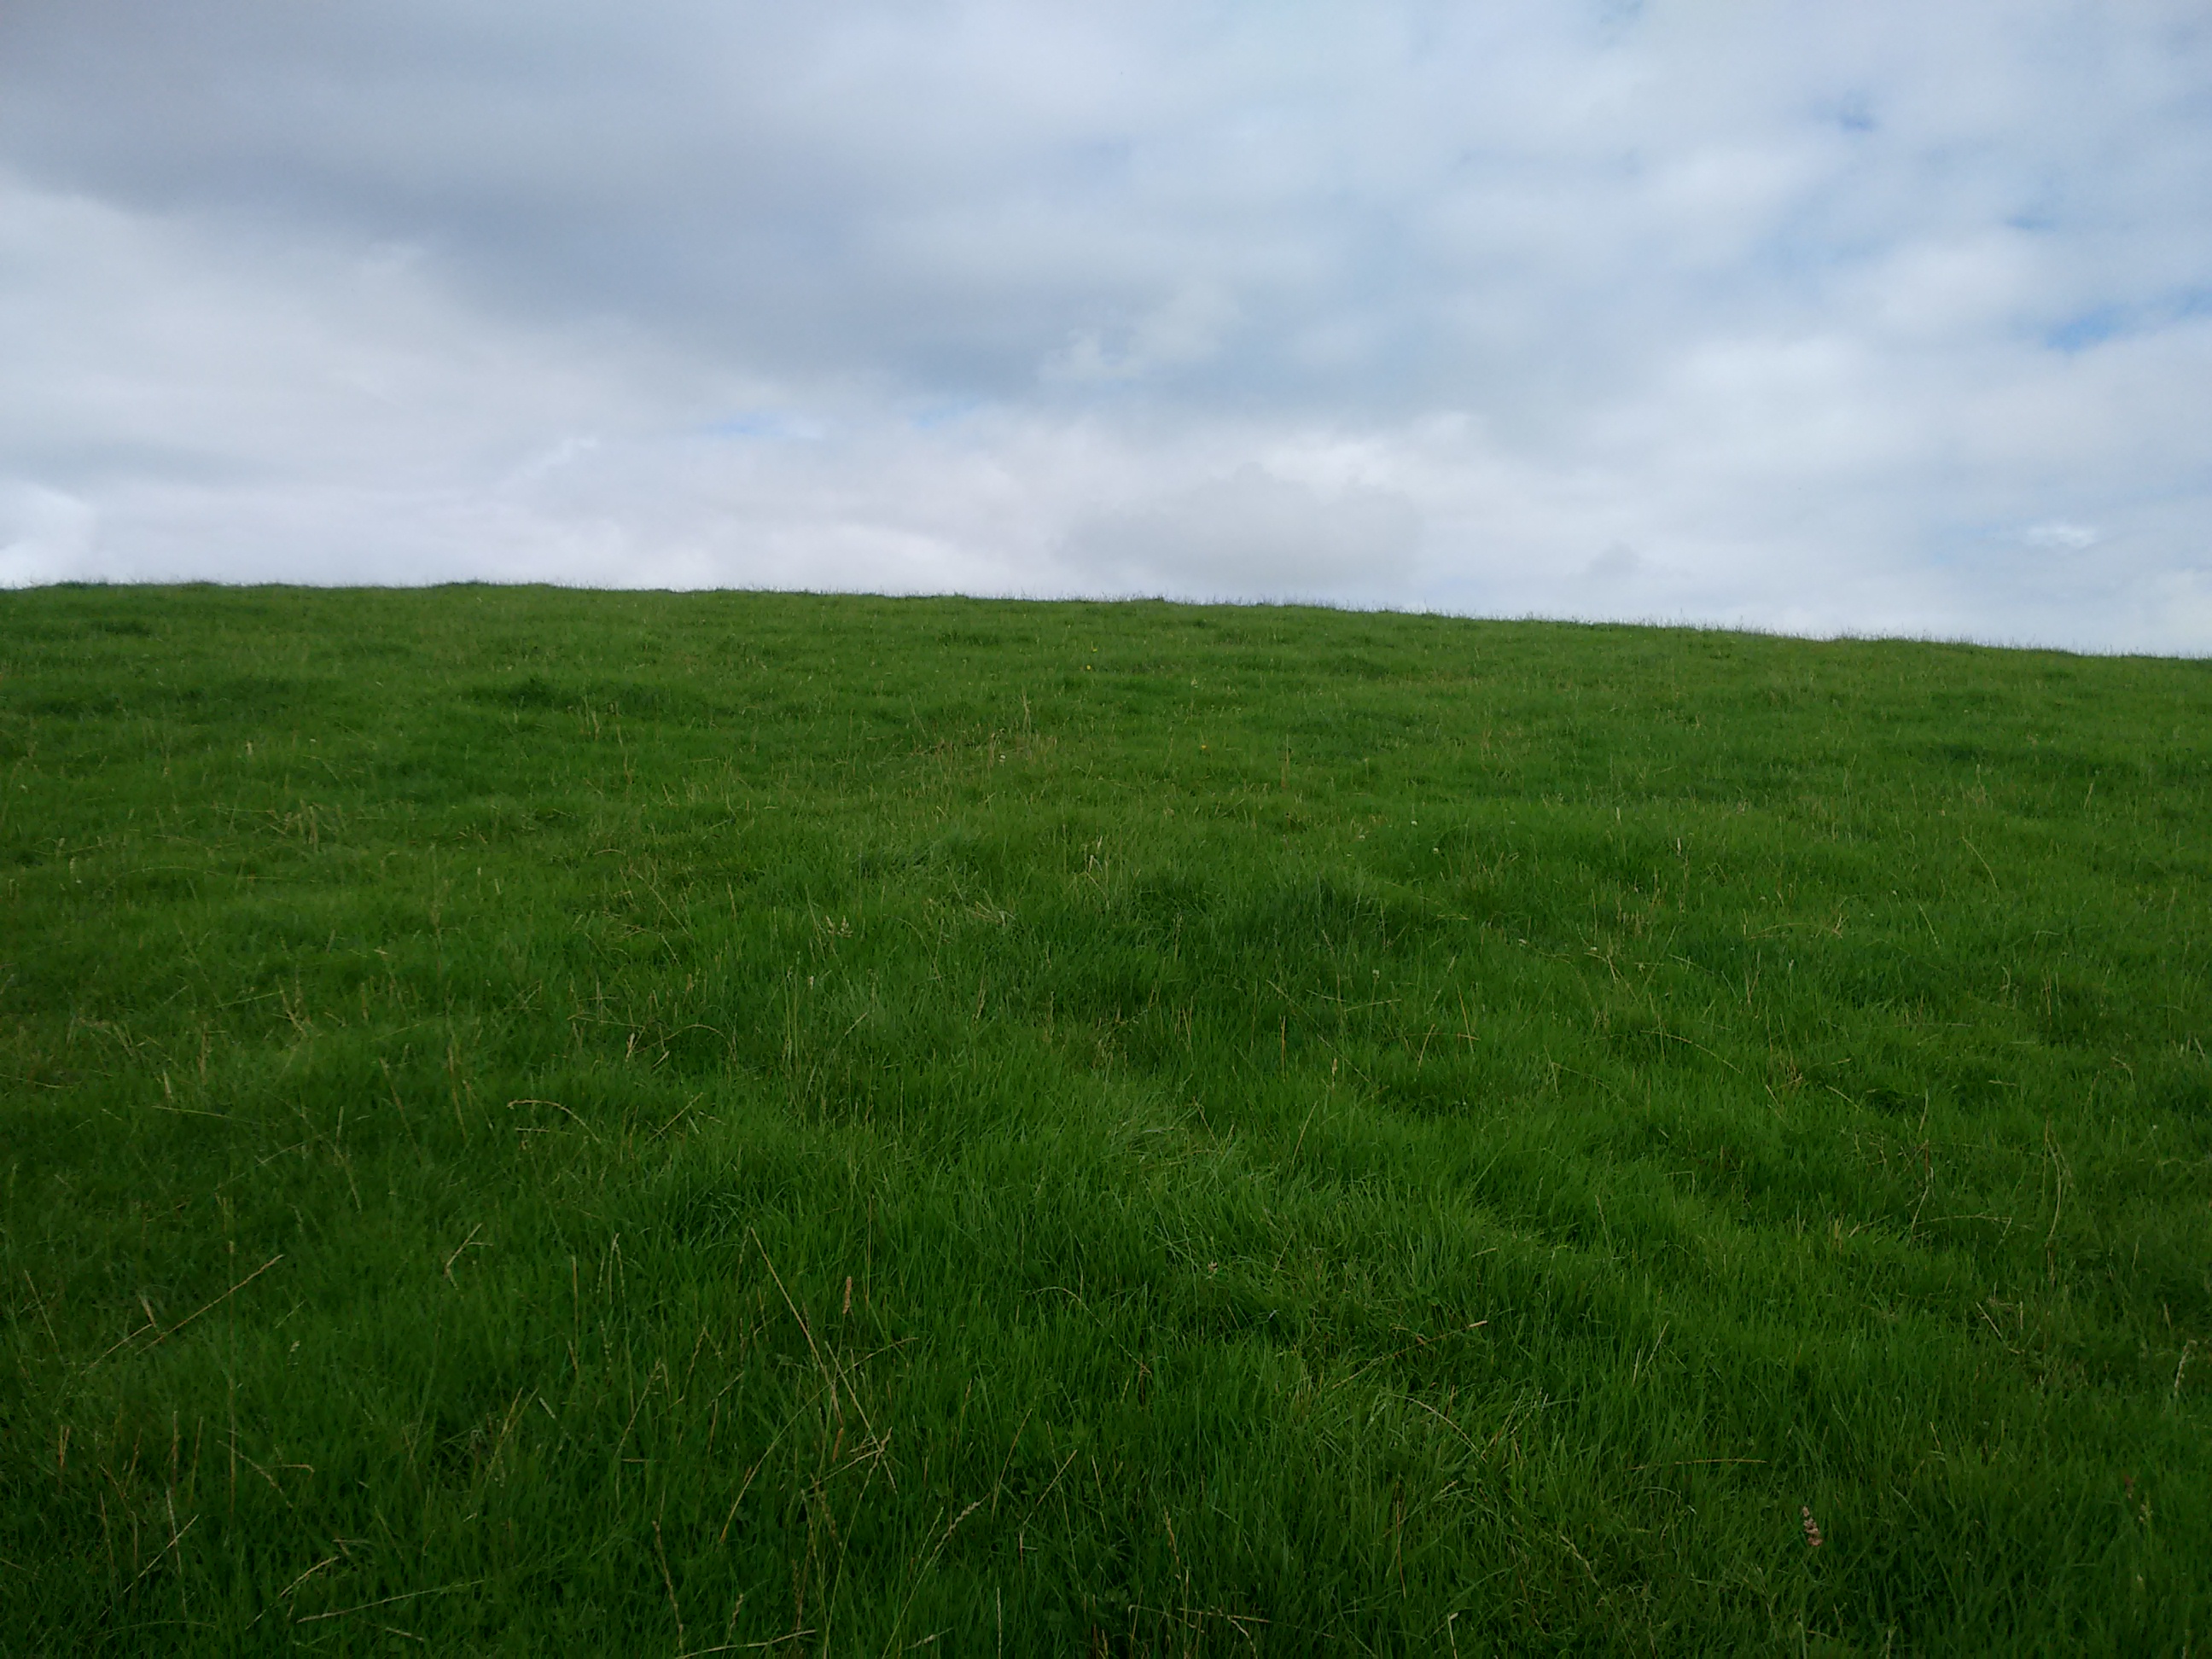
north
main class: Grassland
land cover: Grassland without tree/shrub cover
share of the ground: > 75 %
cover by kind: herbaceous plants 100 %
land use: Agriculture (excluding fallow land and kitchen gardens)
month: August
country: GB
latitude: 54.3769
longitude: -6.8704
